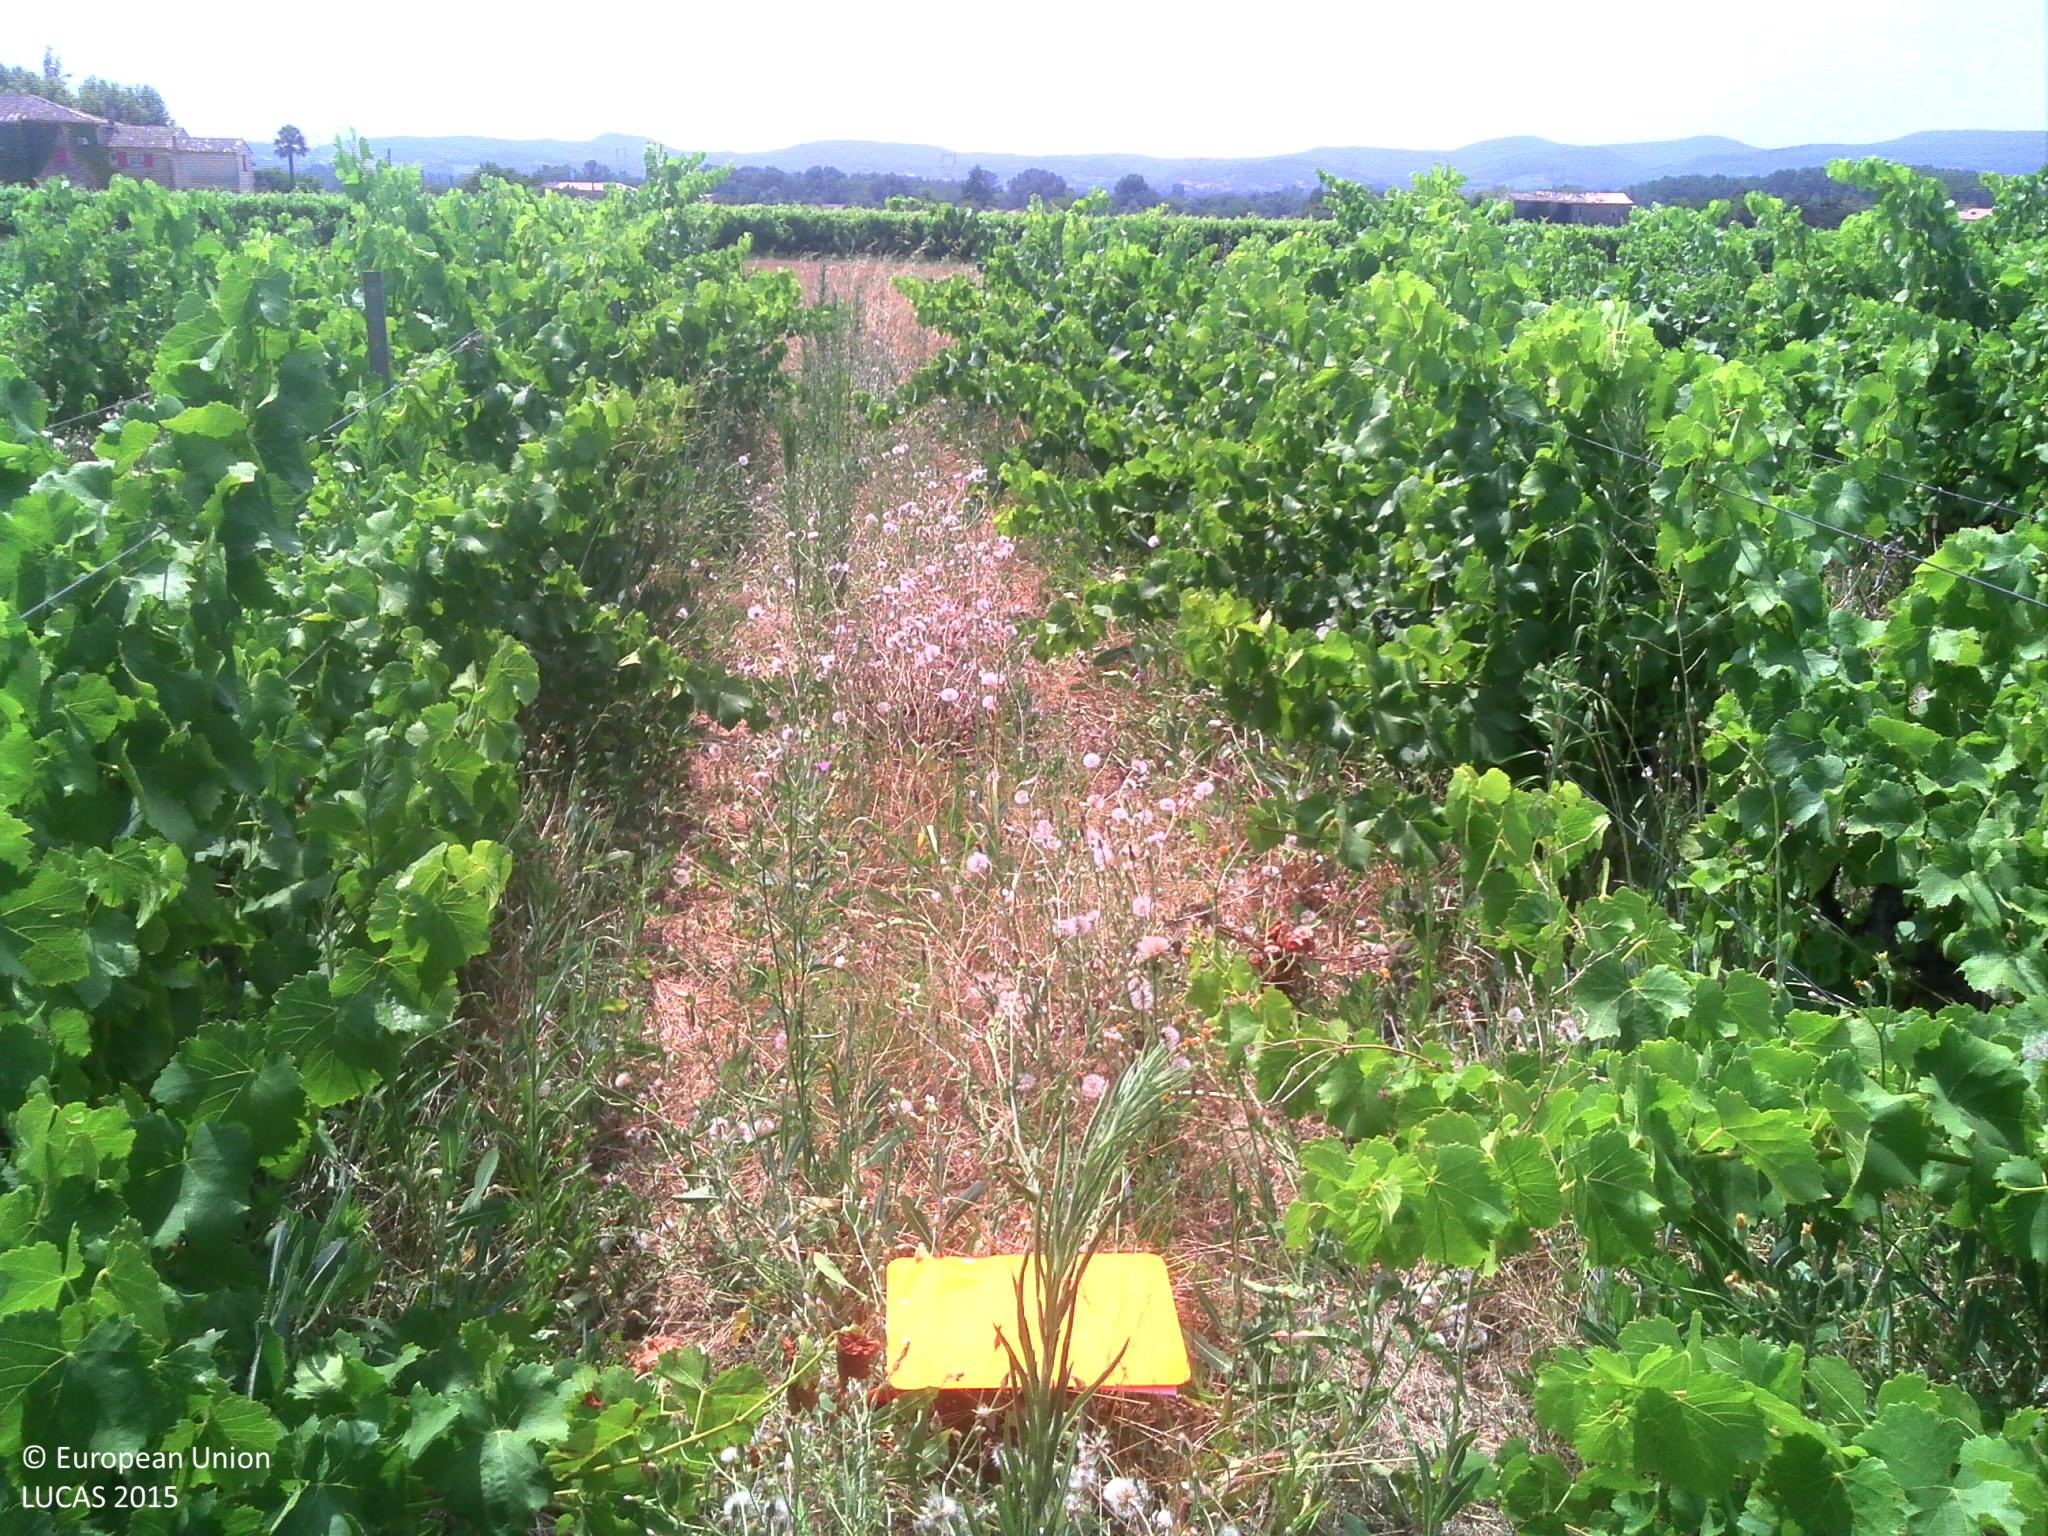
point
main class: Cropland
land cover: Vineyards
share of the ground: 50 - 75 %
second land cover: Grassland without tree/shrub cover
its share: 50 - 75 %
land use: Agriculture (excluding fallow land and kitchen gardens)
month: July
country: FR
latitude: 44.3006
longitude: 4.6051
